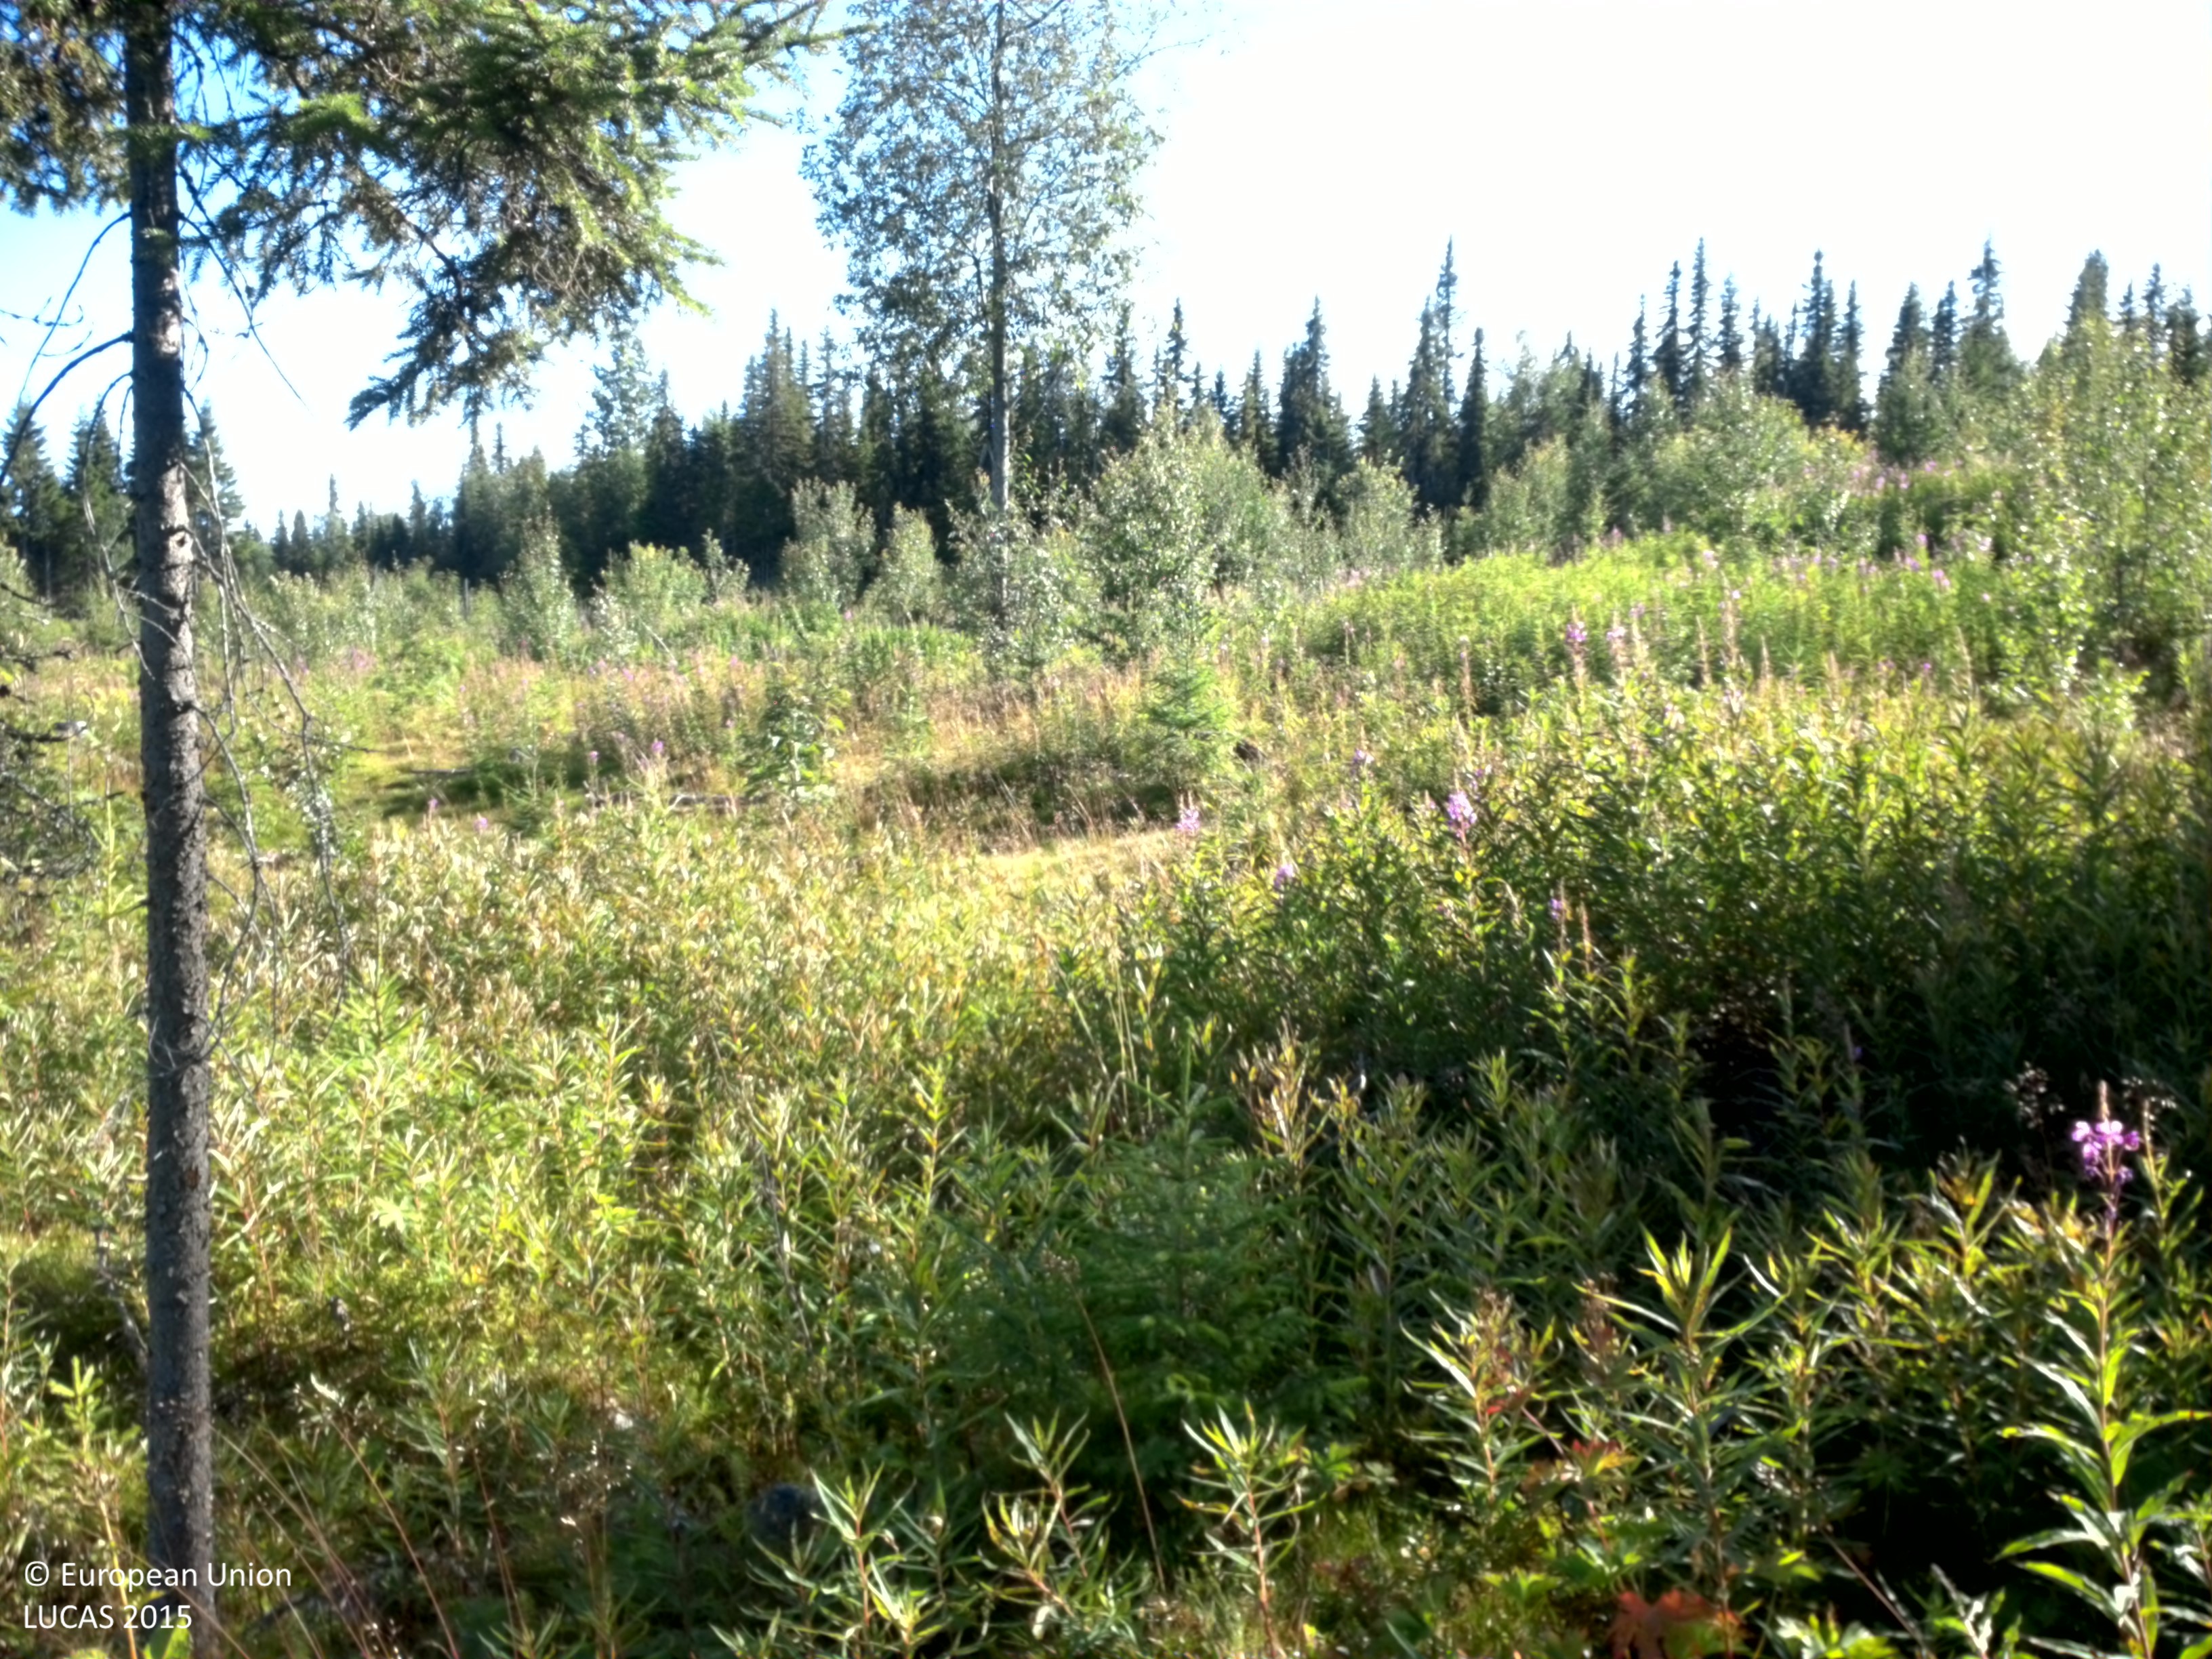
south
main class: Woodland
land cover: Spruce dominated mixed woodland
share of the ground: 10 - 25 %
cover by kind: herbaceous plants 75 %, broadleaved forest trees 10 %, shrubs 10 %, coniferous forest trees 5 %
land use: Forestry
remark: Clear cut
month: August
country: SE
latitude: 64.6972
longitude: 16.1115
